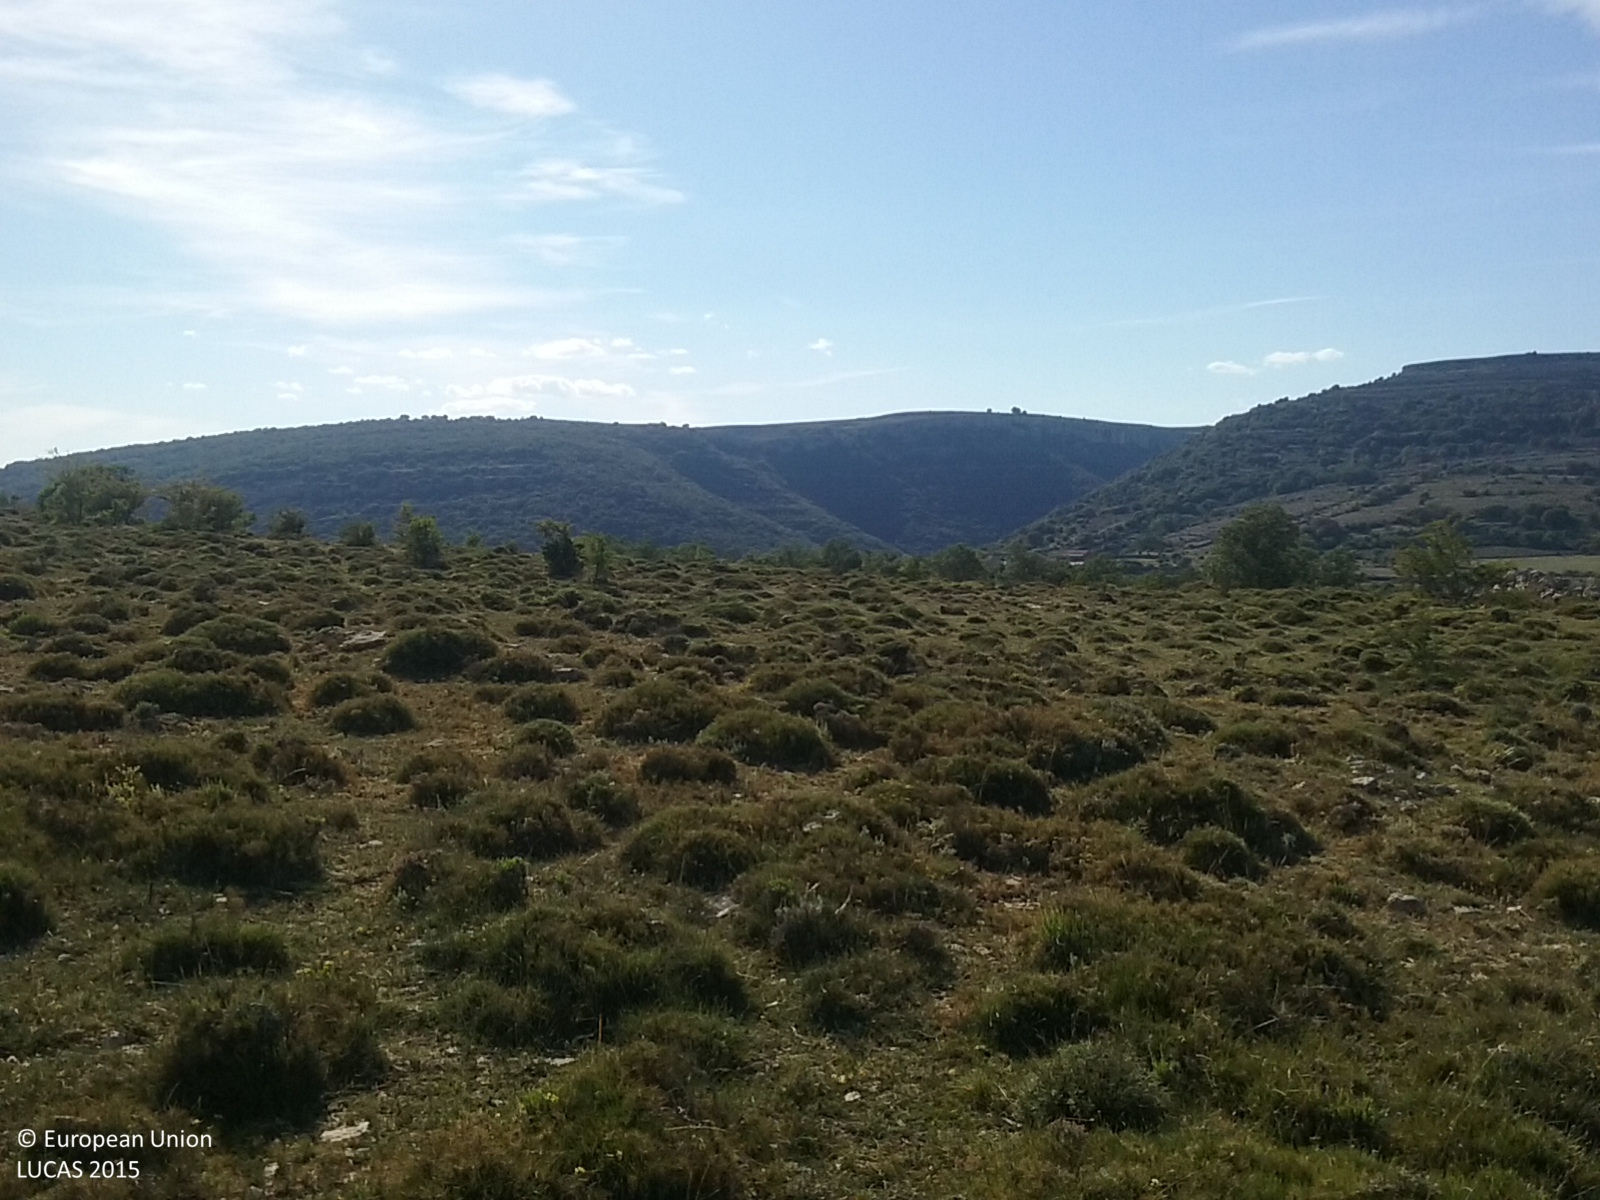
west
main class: Shrubland
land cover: Shrubland without tree cover
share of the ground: > 75 %
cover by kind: herbaceous plants 60 %, shrubs 30 %
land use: Agriculture (excluding fallow land and kitchen gardens)
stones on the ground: 25 - 50 %
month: May
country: ES
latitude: 40.4231
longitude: -0.0590
